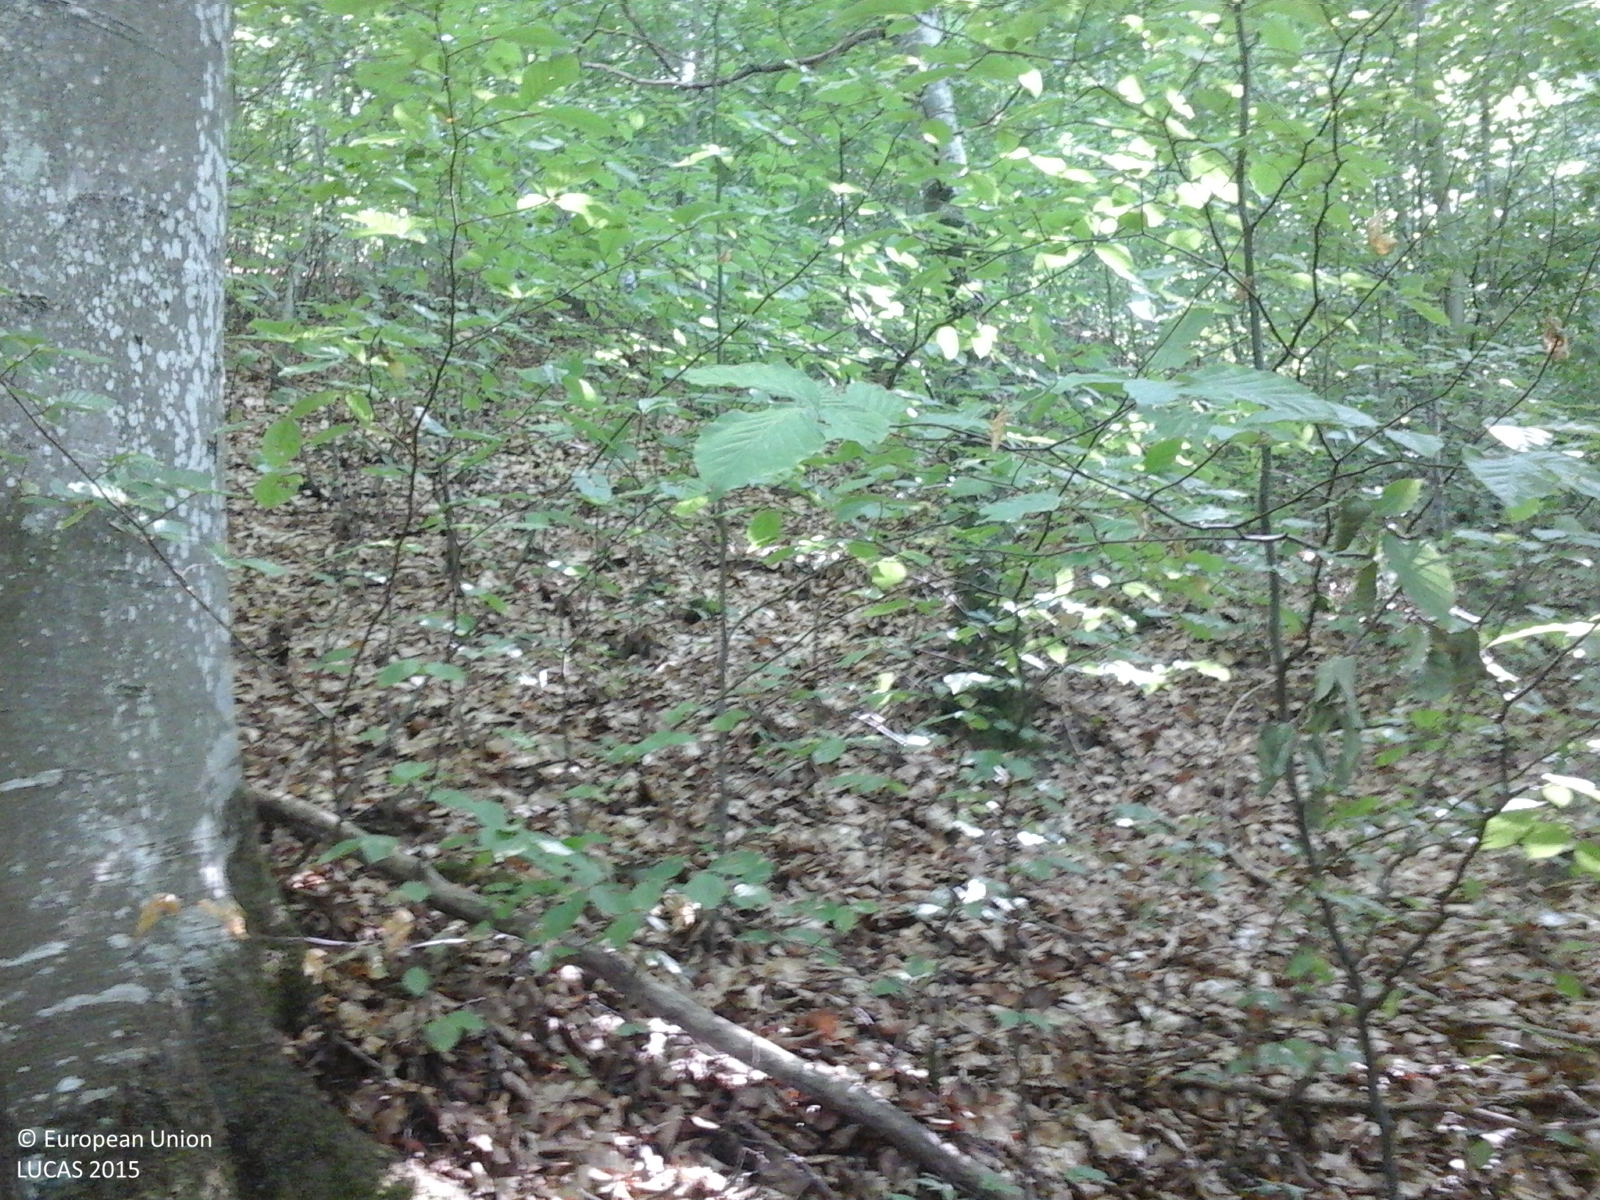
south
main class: Woodland
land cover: Broadleaved woodland
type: beech forest
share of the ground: > 75 %
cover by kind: broadleaved forest trees 100 %
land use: Forestry
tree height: > 5 m
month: September
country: RO
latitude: 47.8201
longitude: 24.2615
